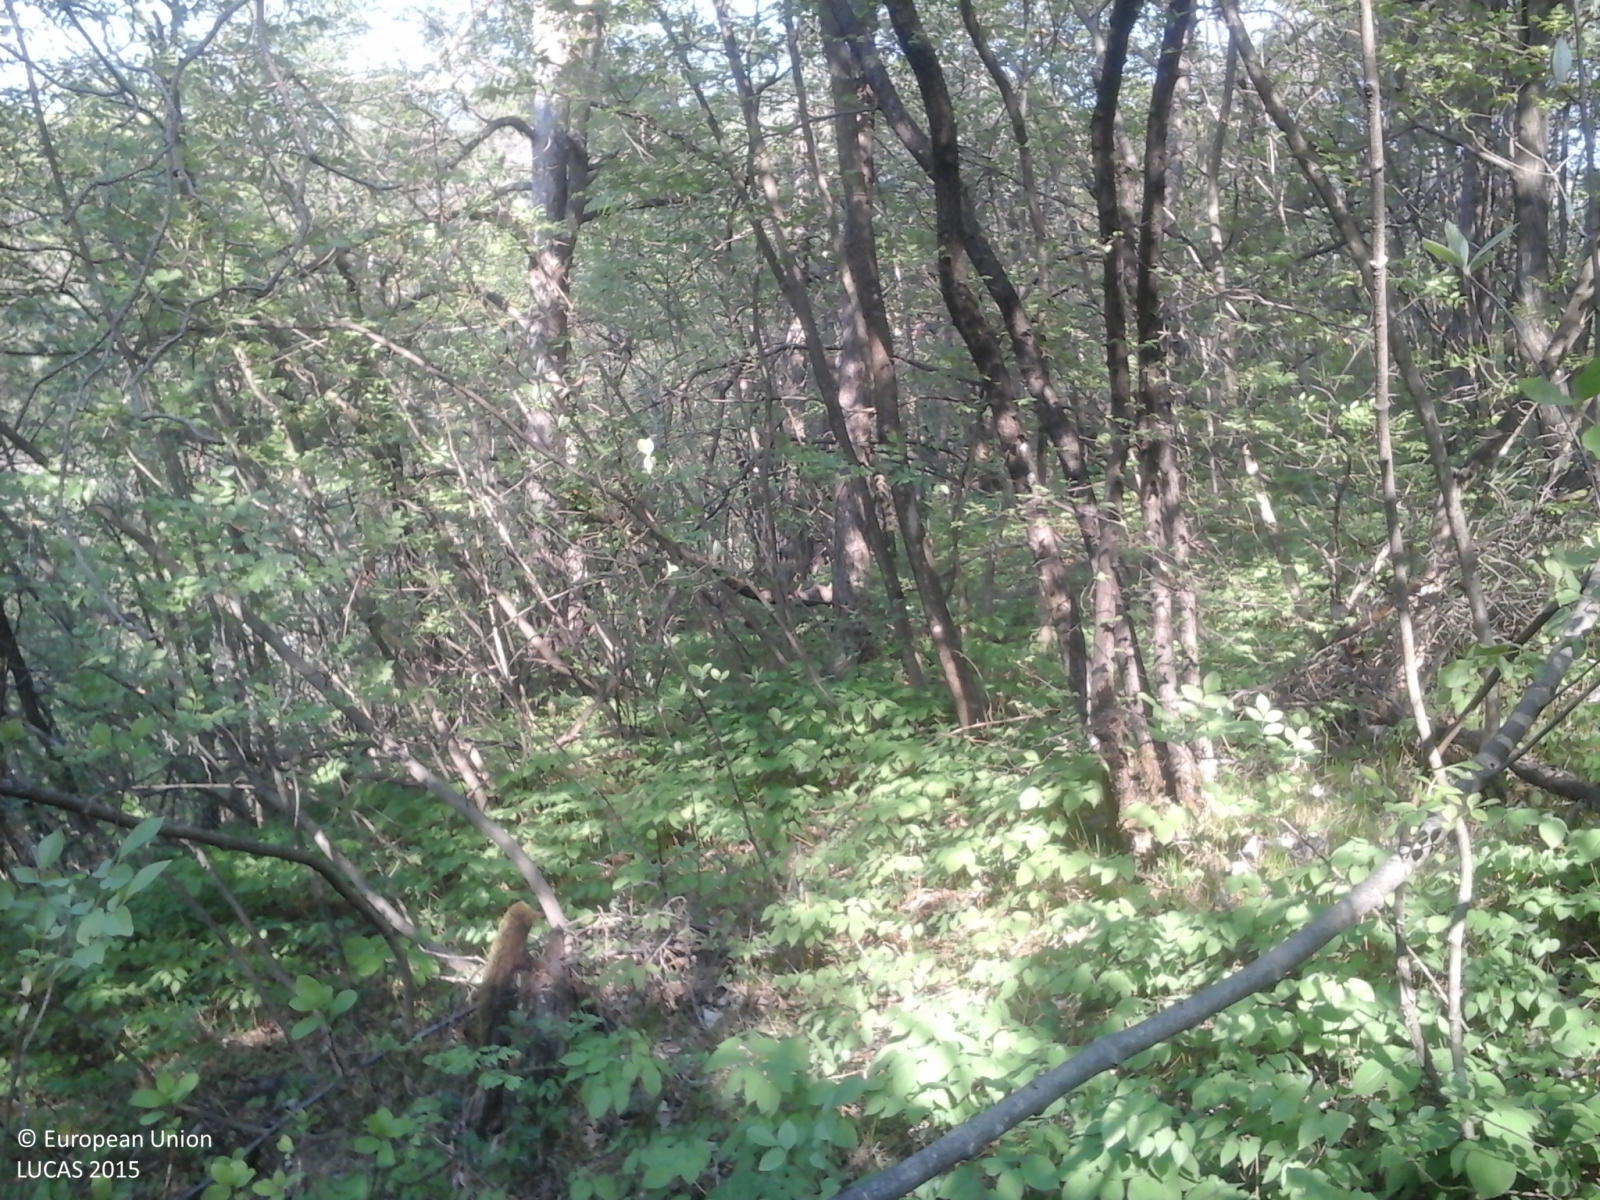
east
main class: Woodland
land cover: Broadleaved woodland
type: thermophilous deciduous forest
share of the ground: > 75 %
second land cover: Grassland without tree/shrub cover
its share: > 75 %
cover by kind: broadleaved forest trees 95 %, coniferous forest trees 5 %
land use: Forestry
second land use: Sport
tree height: > 5 m
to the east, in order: Broadleaved woodland; Grassland without tree/shrub cover; Rivers and streams; Broadleaved woodland; Grassland with sparse tree/shrub cover; Vineyards
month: April
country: IT
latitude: 46.1111
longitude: 11.1241
